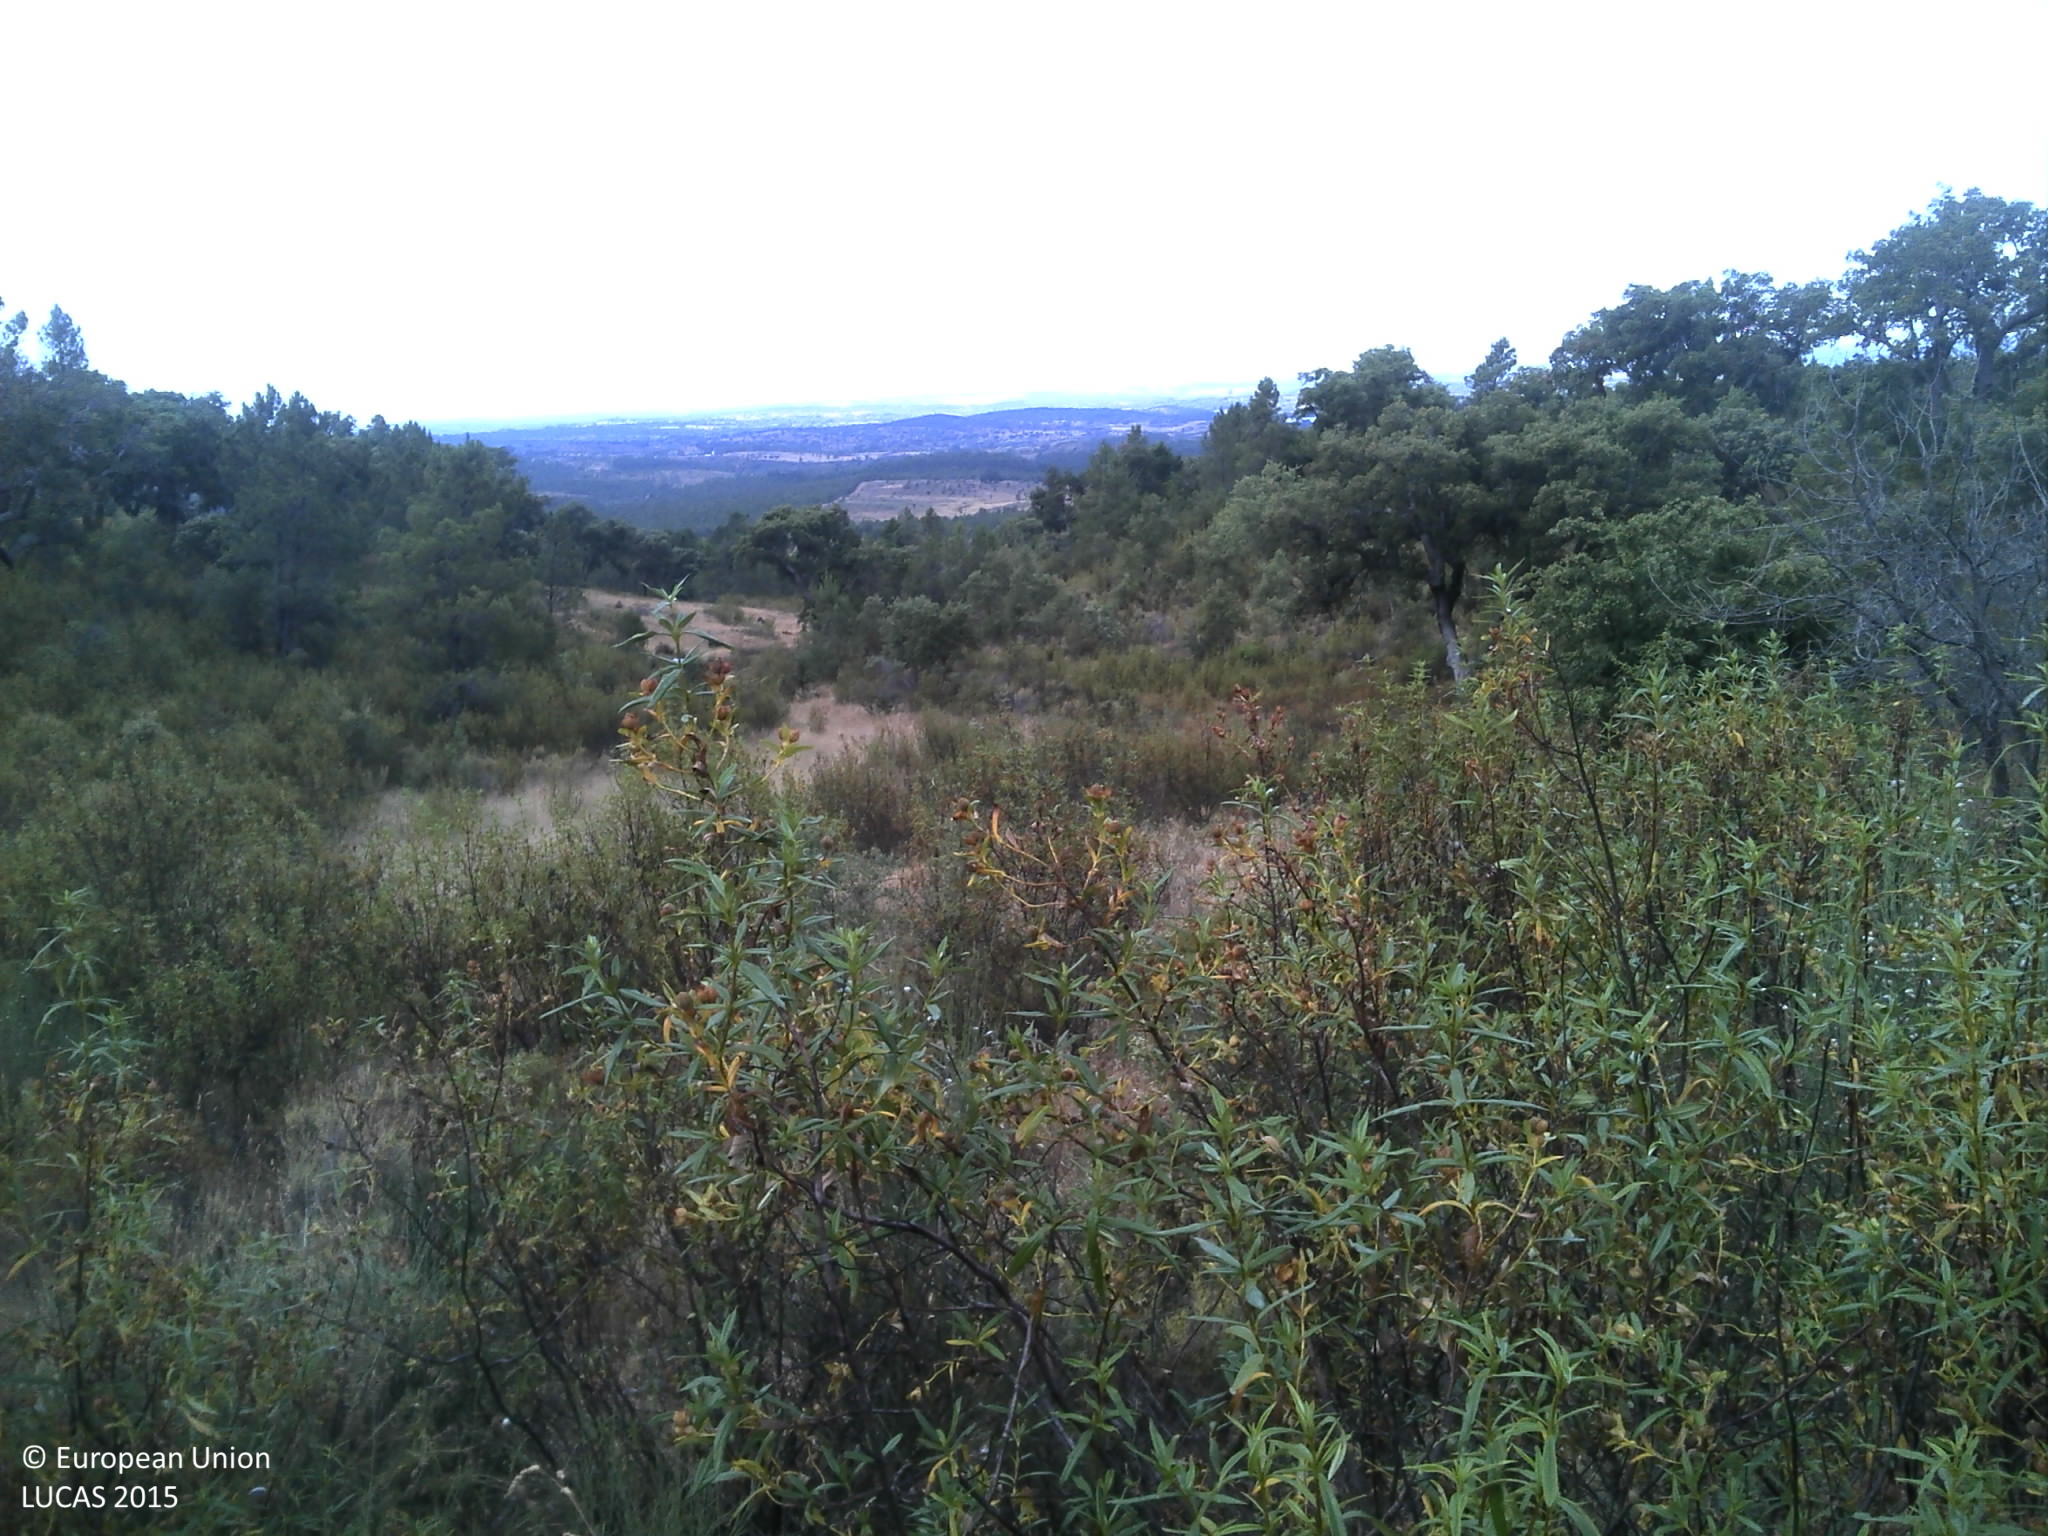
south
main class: Woodland
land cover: Broadleaved woodland
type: broadleaved evergreen forest
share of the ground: 25 - 50 %
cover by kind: broadleaved forest trees 40 %, shrubs 40 %, herbaceous plants 10 %, unconsolidated bare surface 5 %
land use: Forestry
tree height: > 5 m
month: June
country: PT
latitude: 40.1904
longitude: -7.2125
